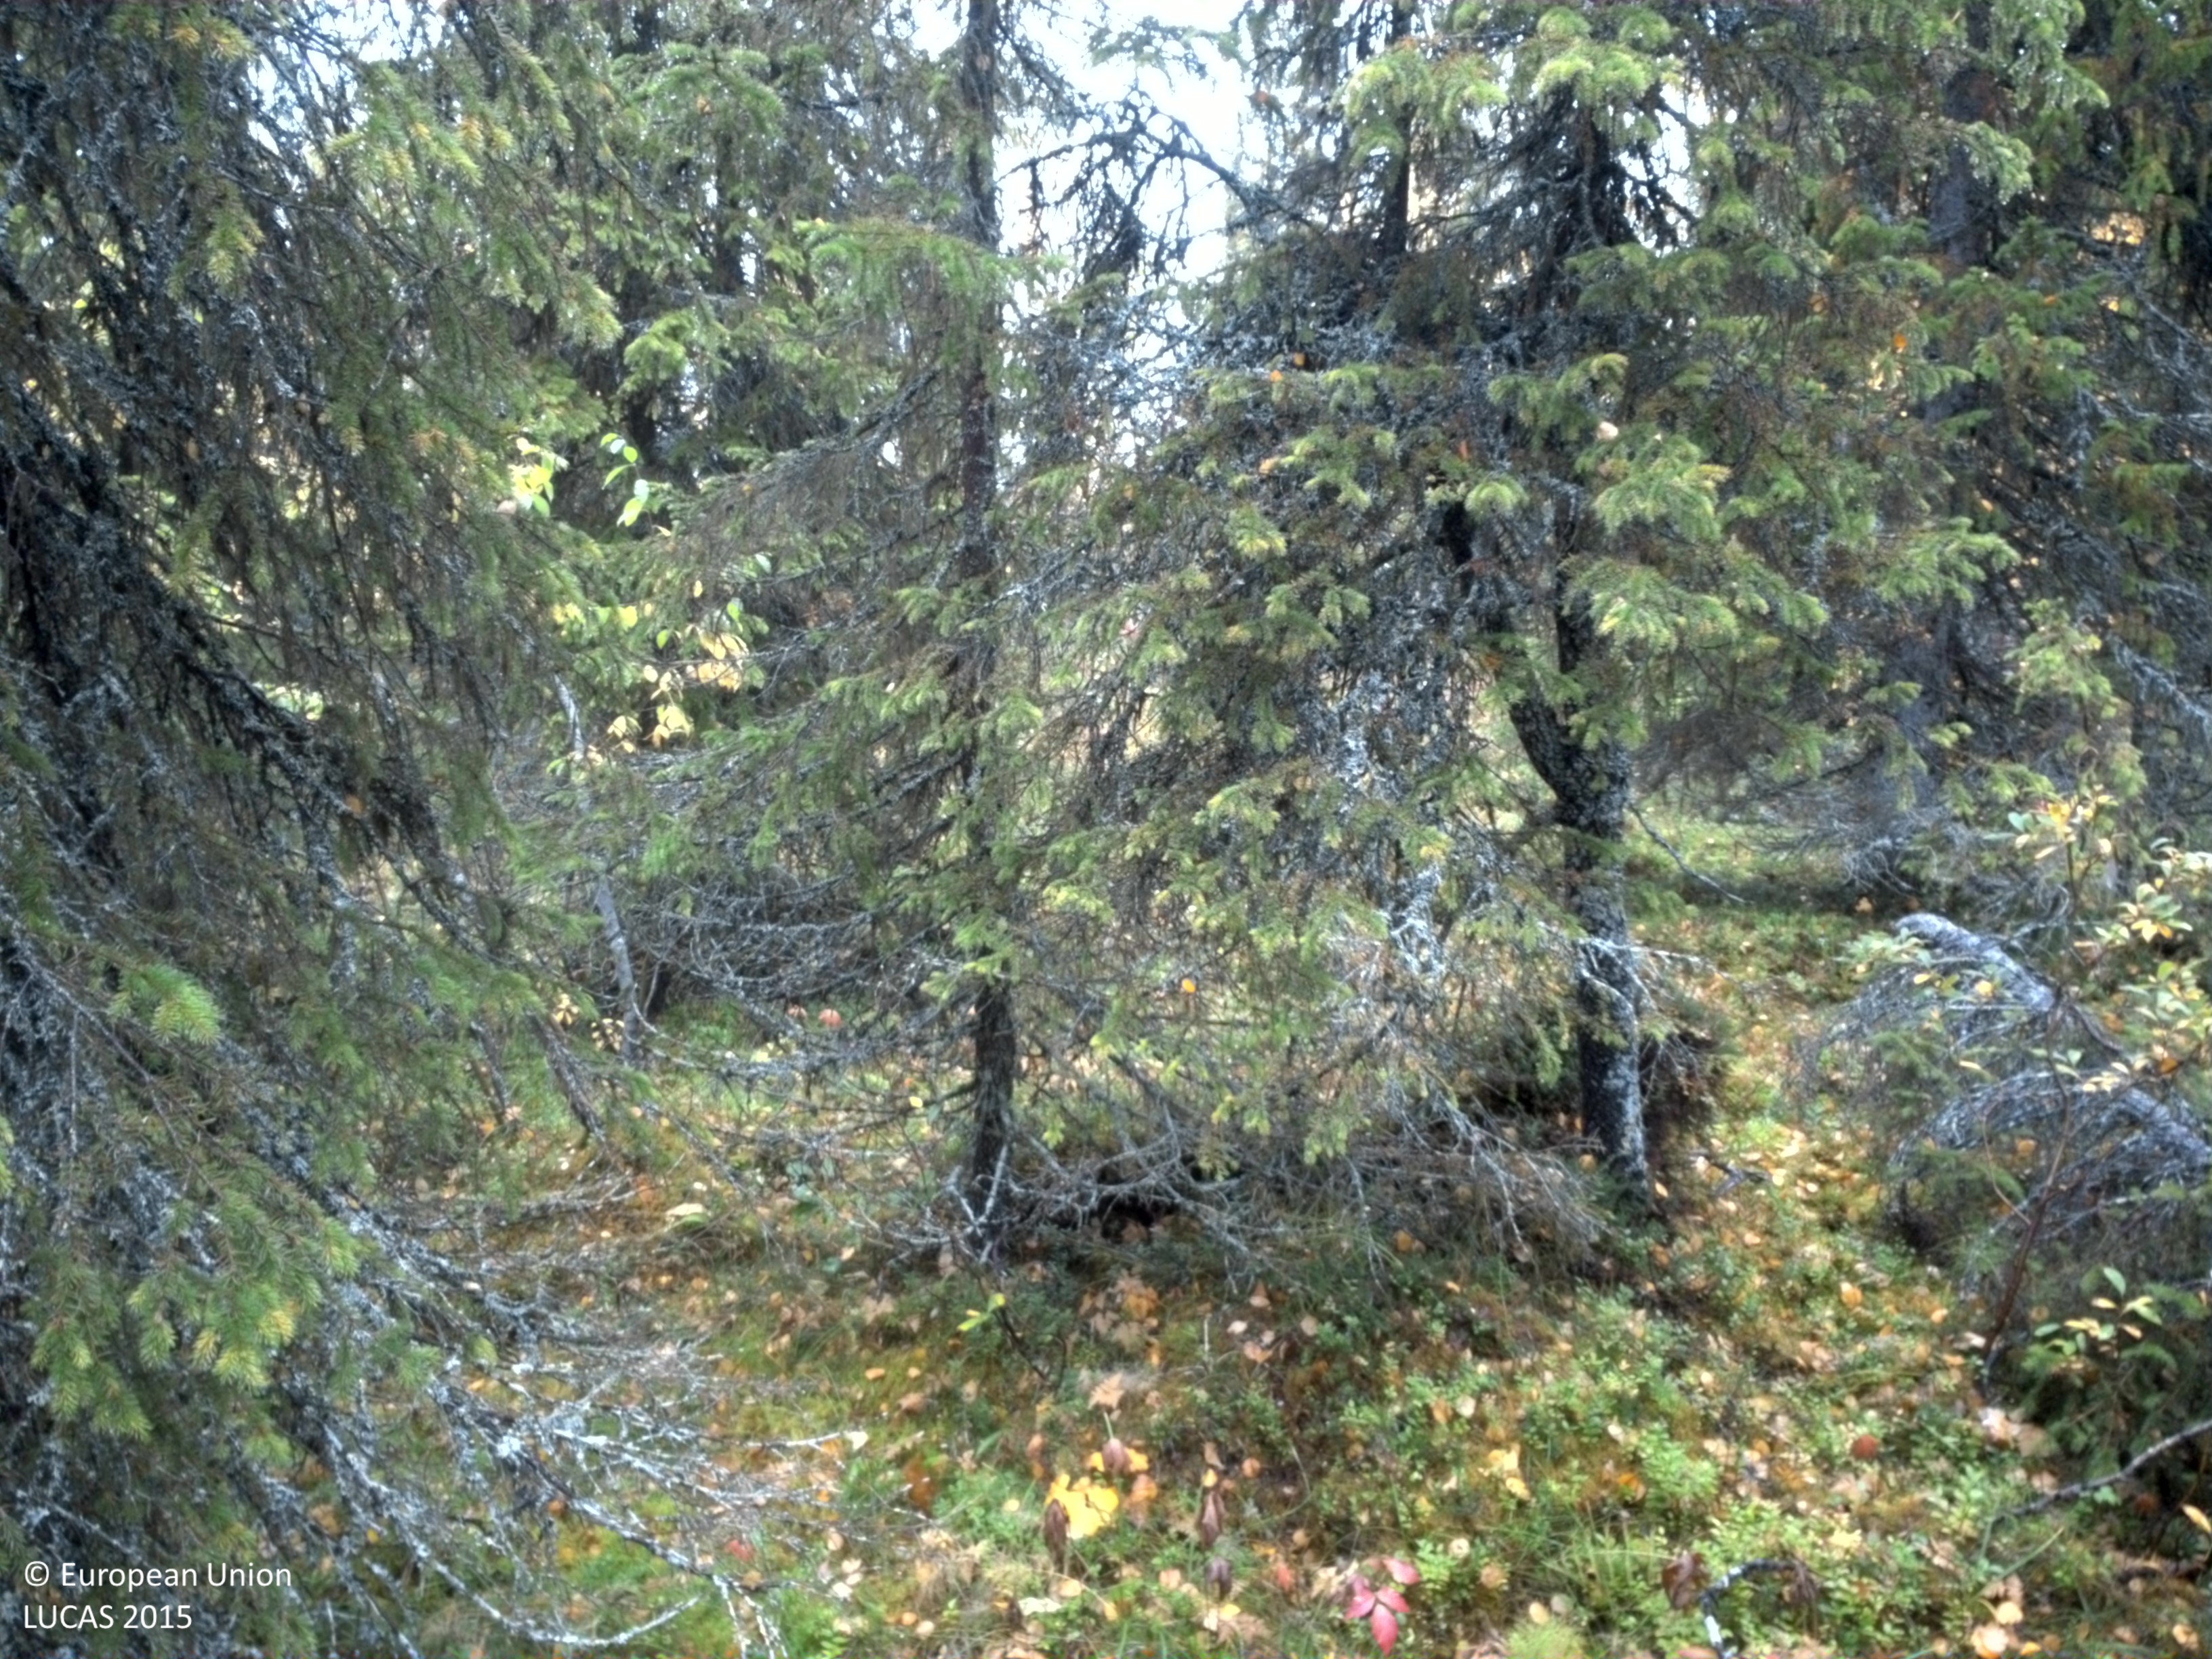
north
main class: Woodland
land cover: Spruce dominated mixed woodland
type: boreal forest
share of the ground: 25 - 50 %
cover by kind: coniferous forest trees 30 %, shrubs 20 %, herbaceous plants 20 %, lichens and mosses 20 %, broadleaved forest trees 10 %
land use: Forestry
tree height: > 5 m
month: September
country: SE
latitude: 65.2544
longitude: 16.2369
